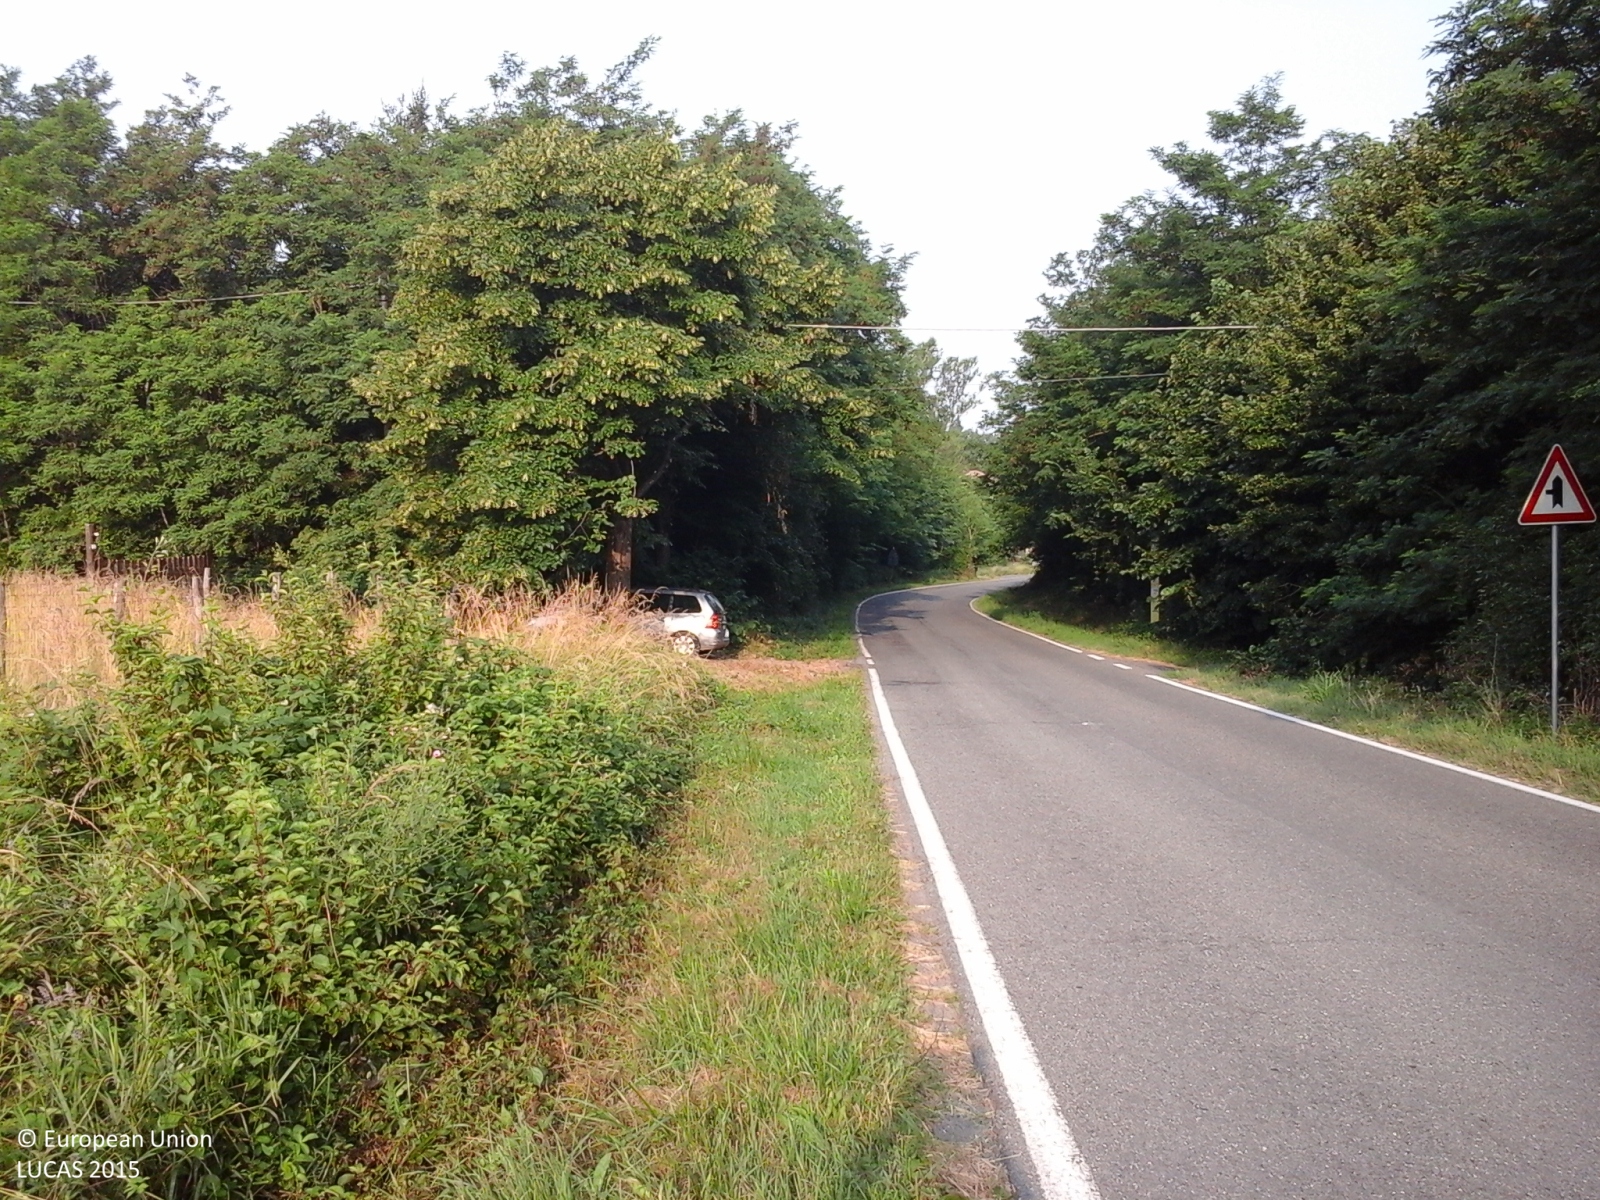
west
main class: Grassland
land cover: Grassland without tree/shrub cover
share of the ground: > 75 %
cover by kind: herbaceous plants 100 %
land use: Agriculture (excluding fallow land and kitchen gardens)
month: July
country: IT
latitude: 44.6311
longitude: 8.7044
